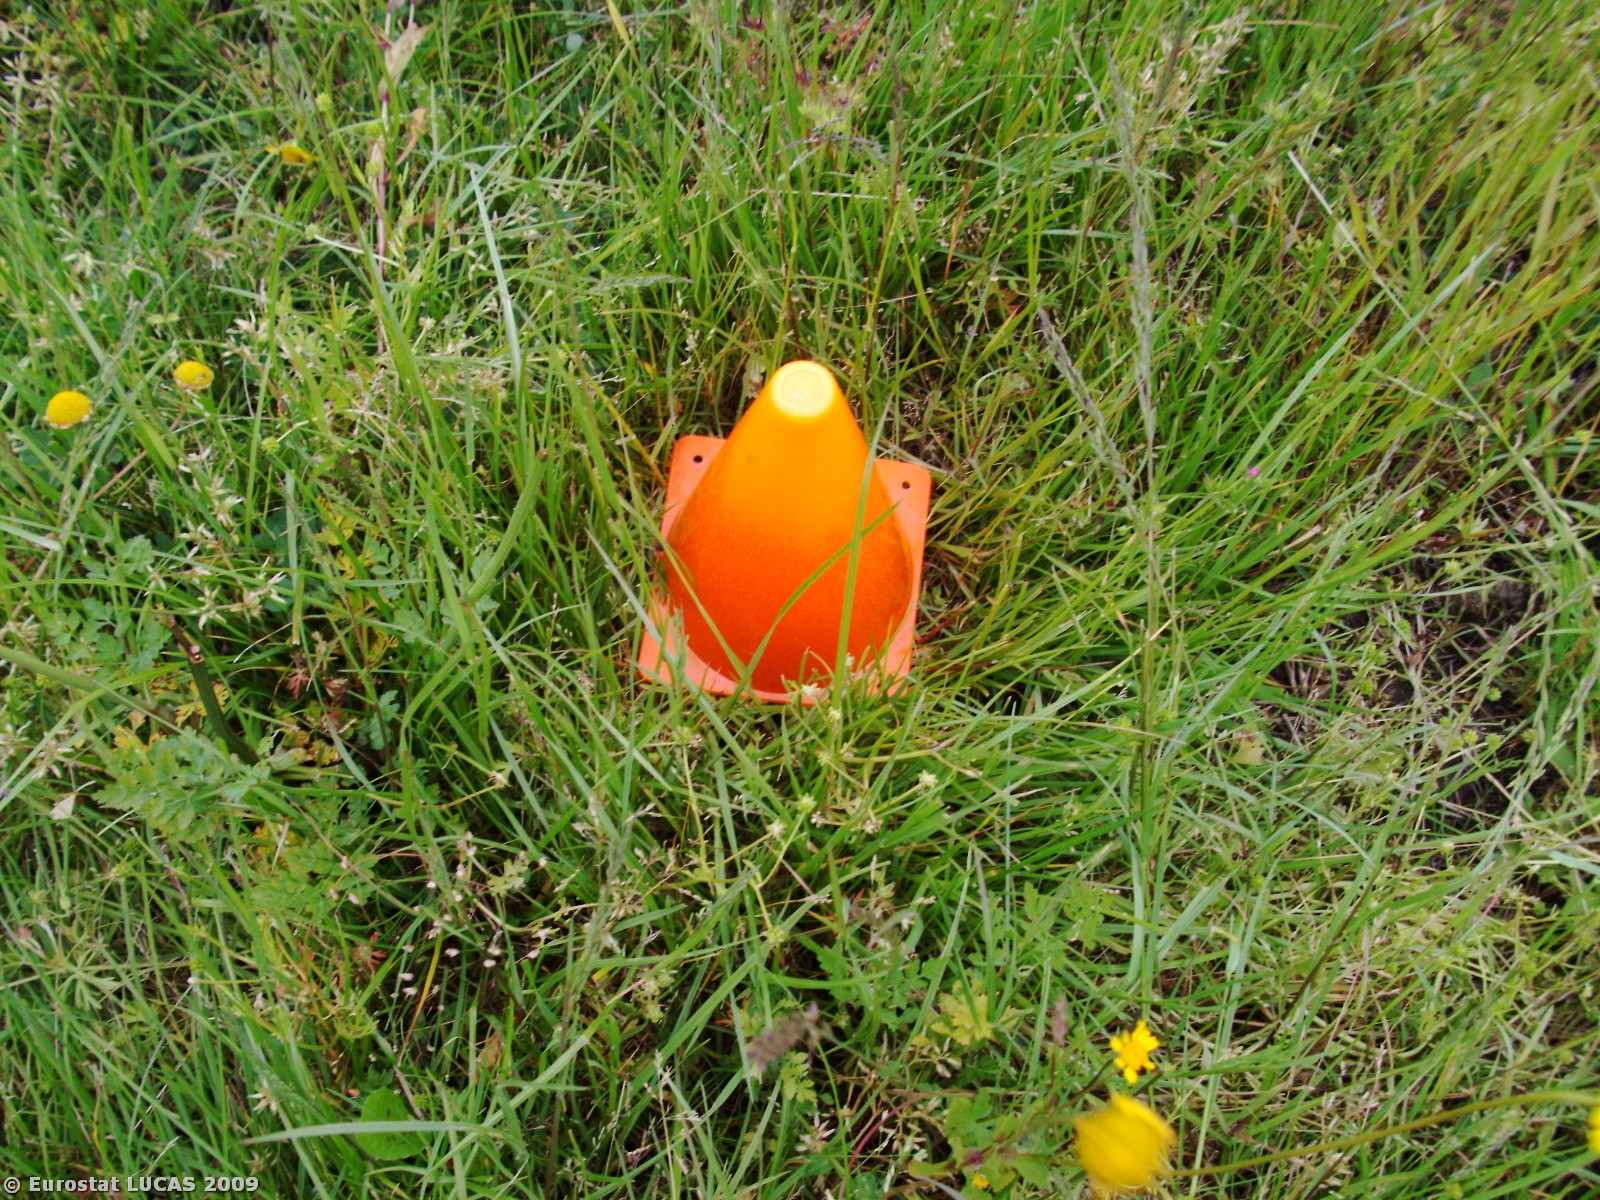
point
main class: Grassland
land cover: Spontaneously vegetated surfaces
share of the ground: > 75 %
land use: Fallow land
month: May
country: PT
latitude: 40.9855
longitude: -8.5105
